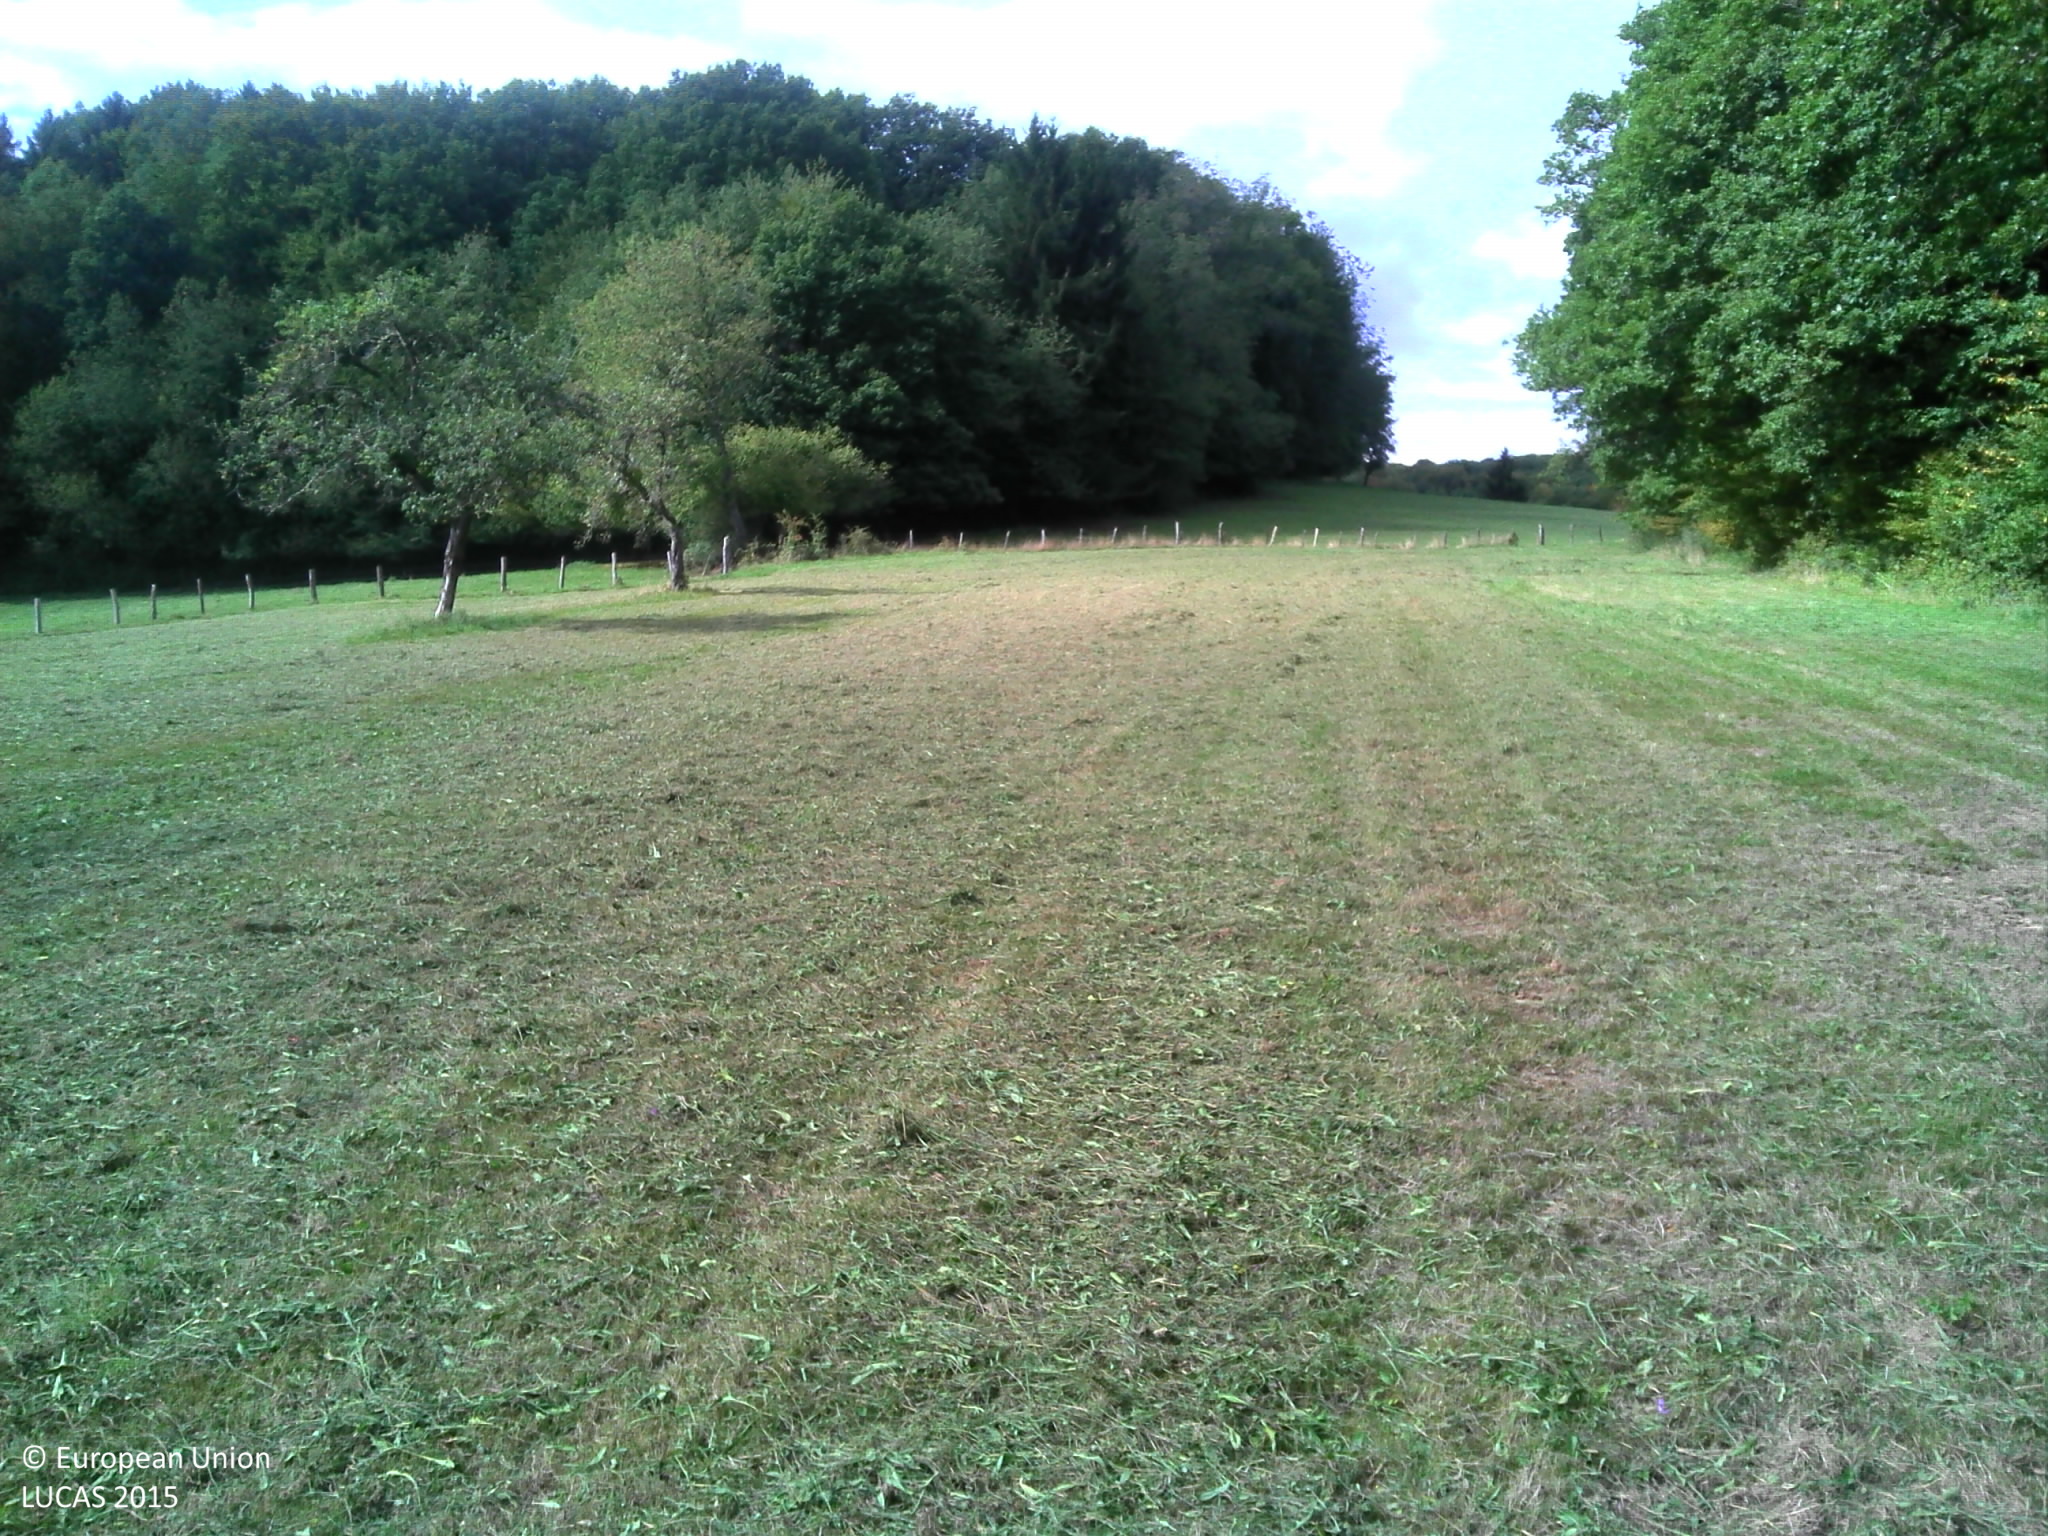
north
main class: Grassland
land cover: Grassland with sparse tree/shrub cover
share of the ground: > 75 %
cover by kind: herbaceous plants 95 %, broadleaved forest trees 5 %
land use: Agriculture (excluding fallow land and kitchen gardens)
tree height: > 5 m
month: September
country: FR
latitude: 47.3455
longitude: 6.1498
